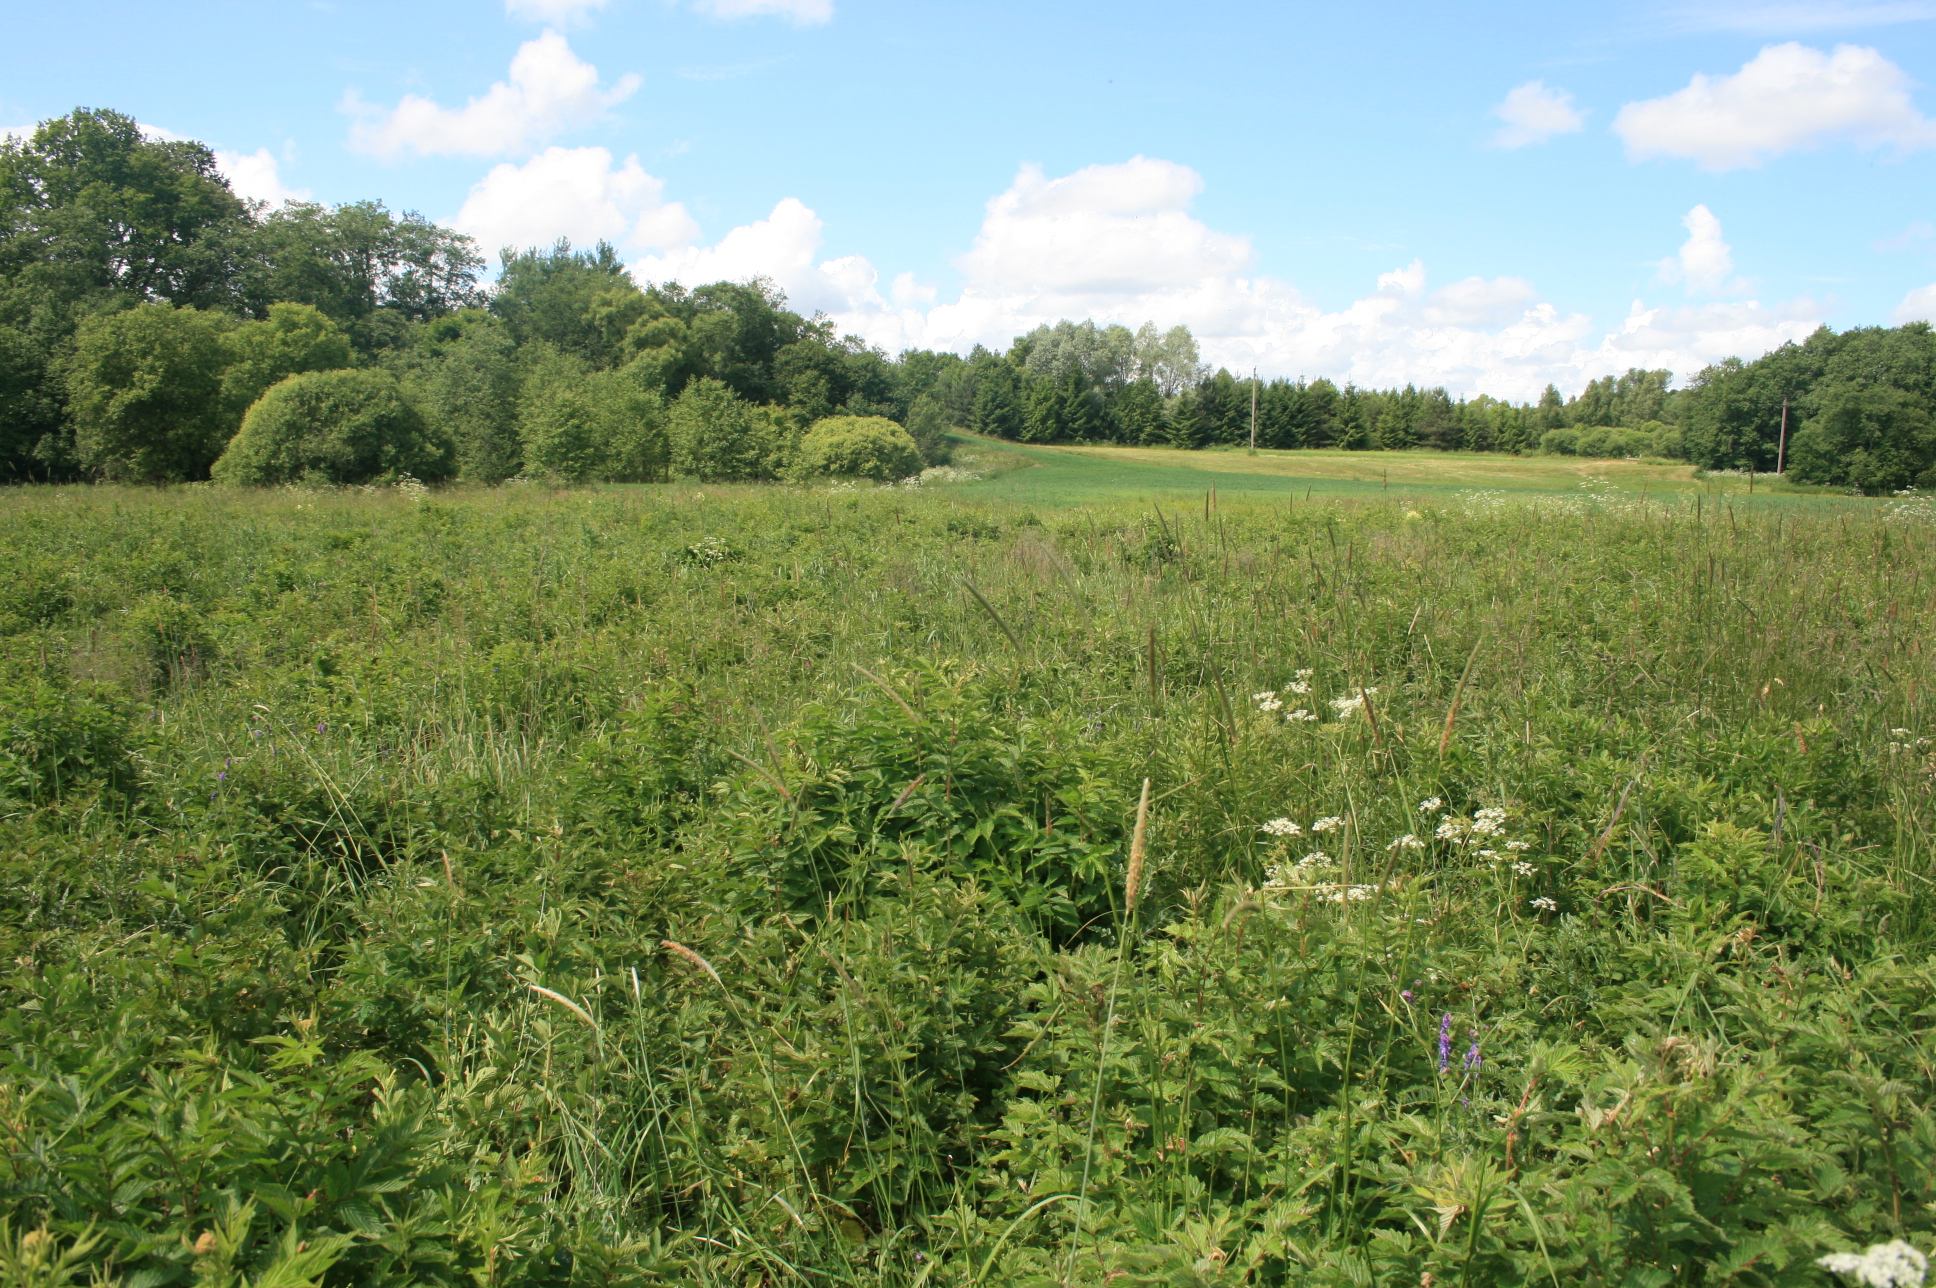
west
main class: Grassland
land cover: Spontaneously vegetated surfaces
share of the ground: > 75 %
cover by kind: herbaceous plants 100 %
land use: Fallow land
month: June
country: LT
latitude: 55.2643
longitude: 22.1258
